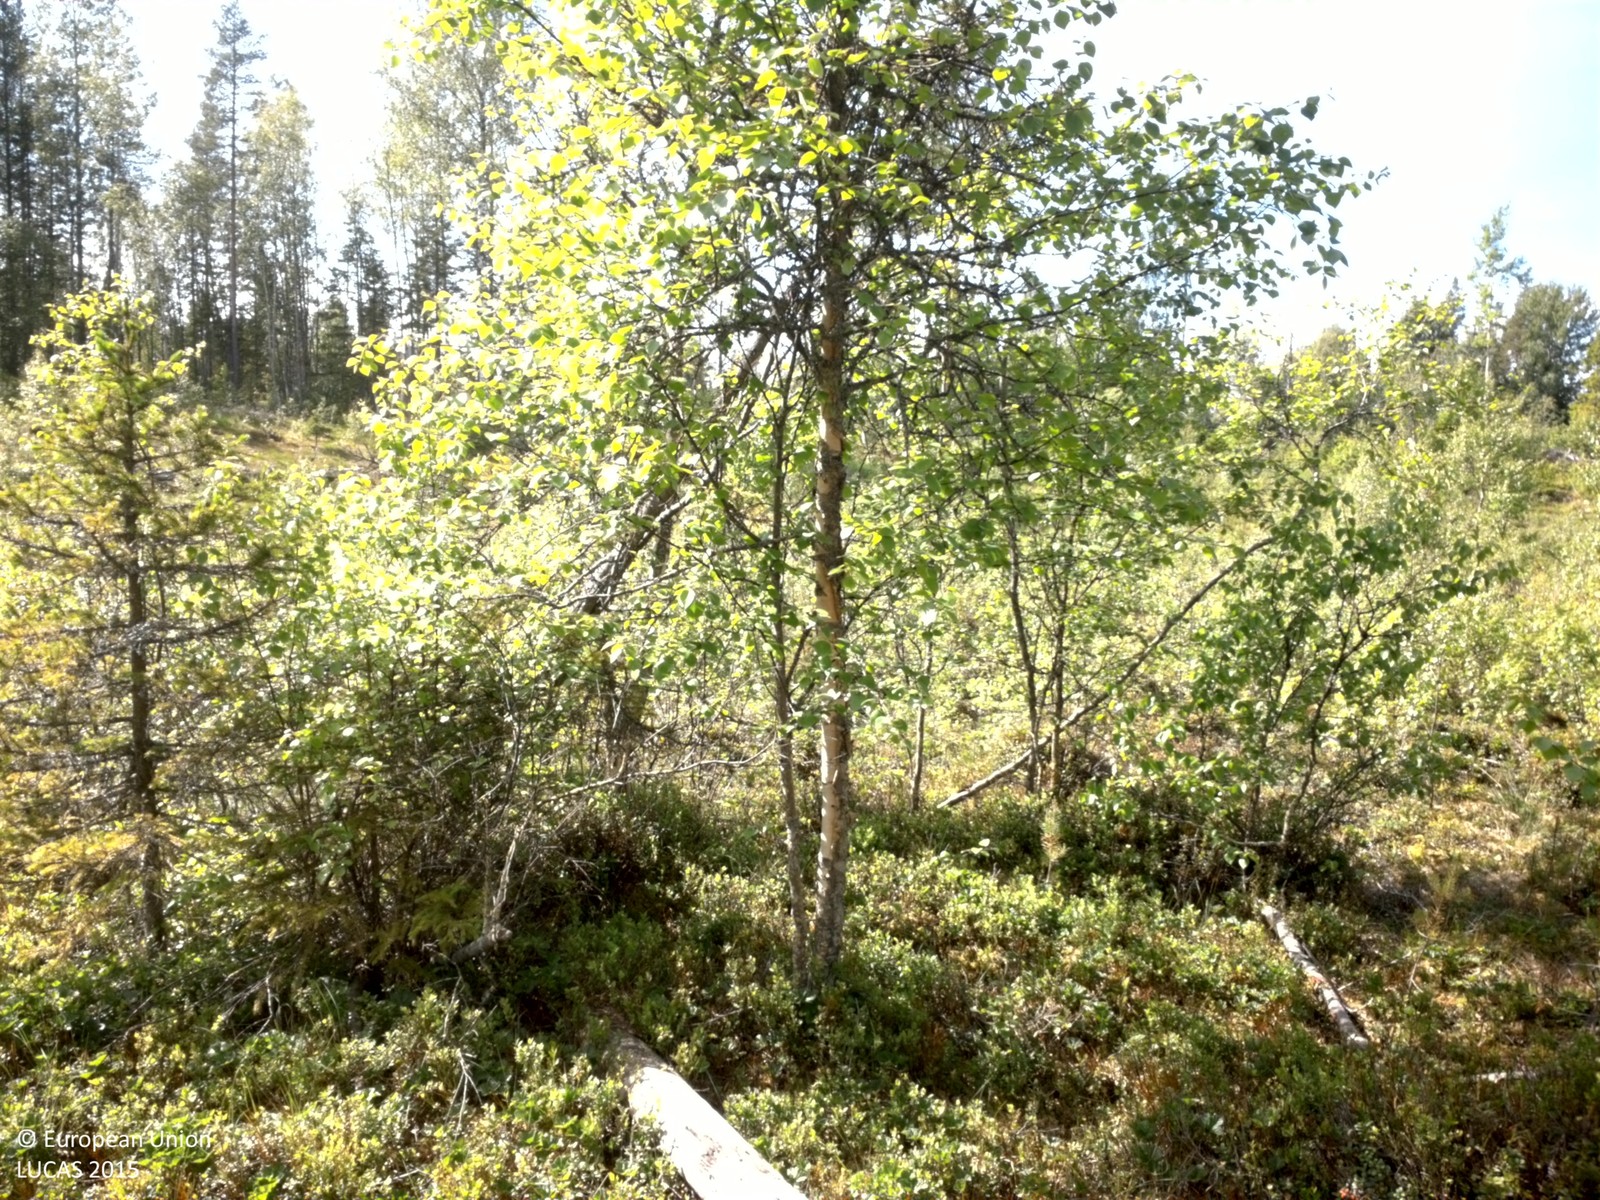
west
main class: Woodland
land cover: Other mixed woodland
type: boreal forest
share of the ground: 25 - 50 %
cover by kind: shrubs 50 %, coniferous forest trees 30 %, broadleaved forest trees 10 %, lichens and mosses 10 %
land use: Forestry
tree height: > 5 m
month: July
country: SE
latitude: 64.4005
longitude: 20.7038
